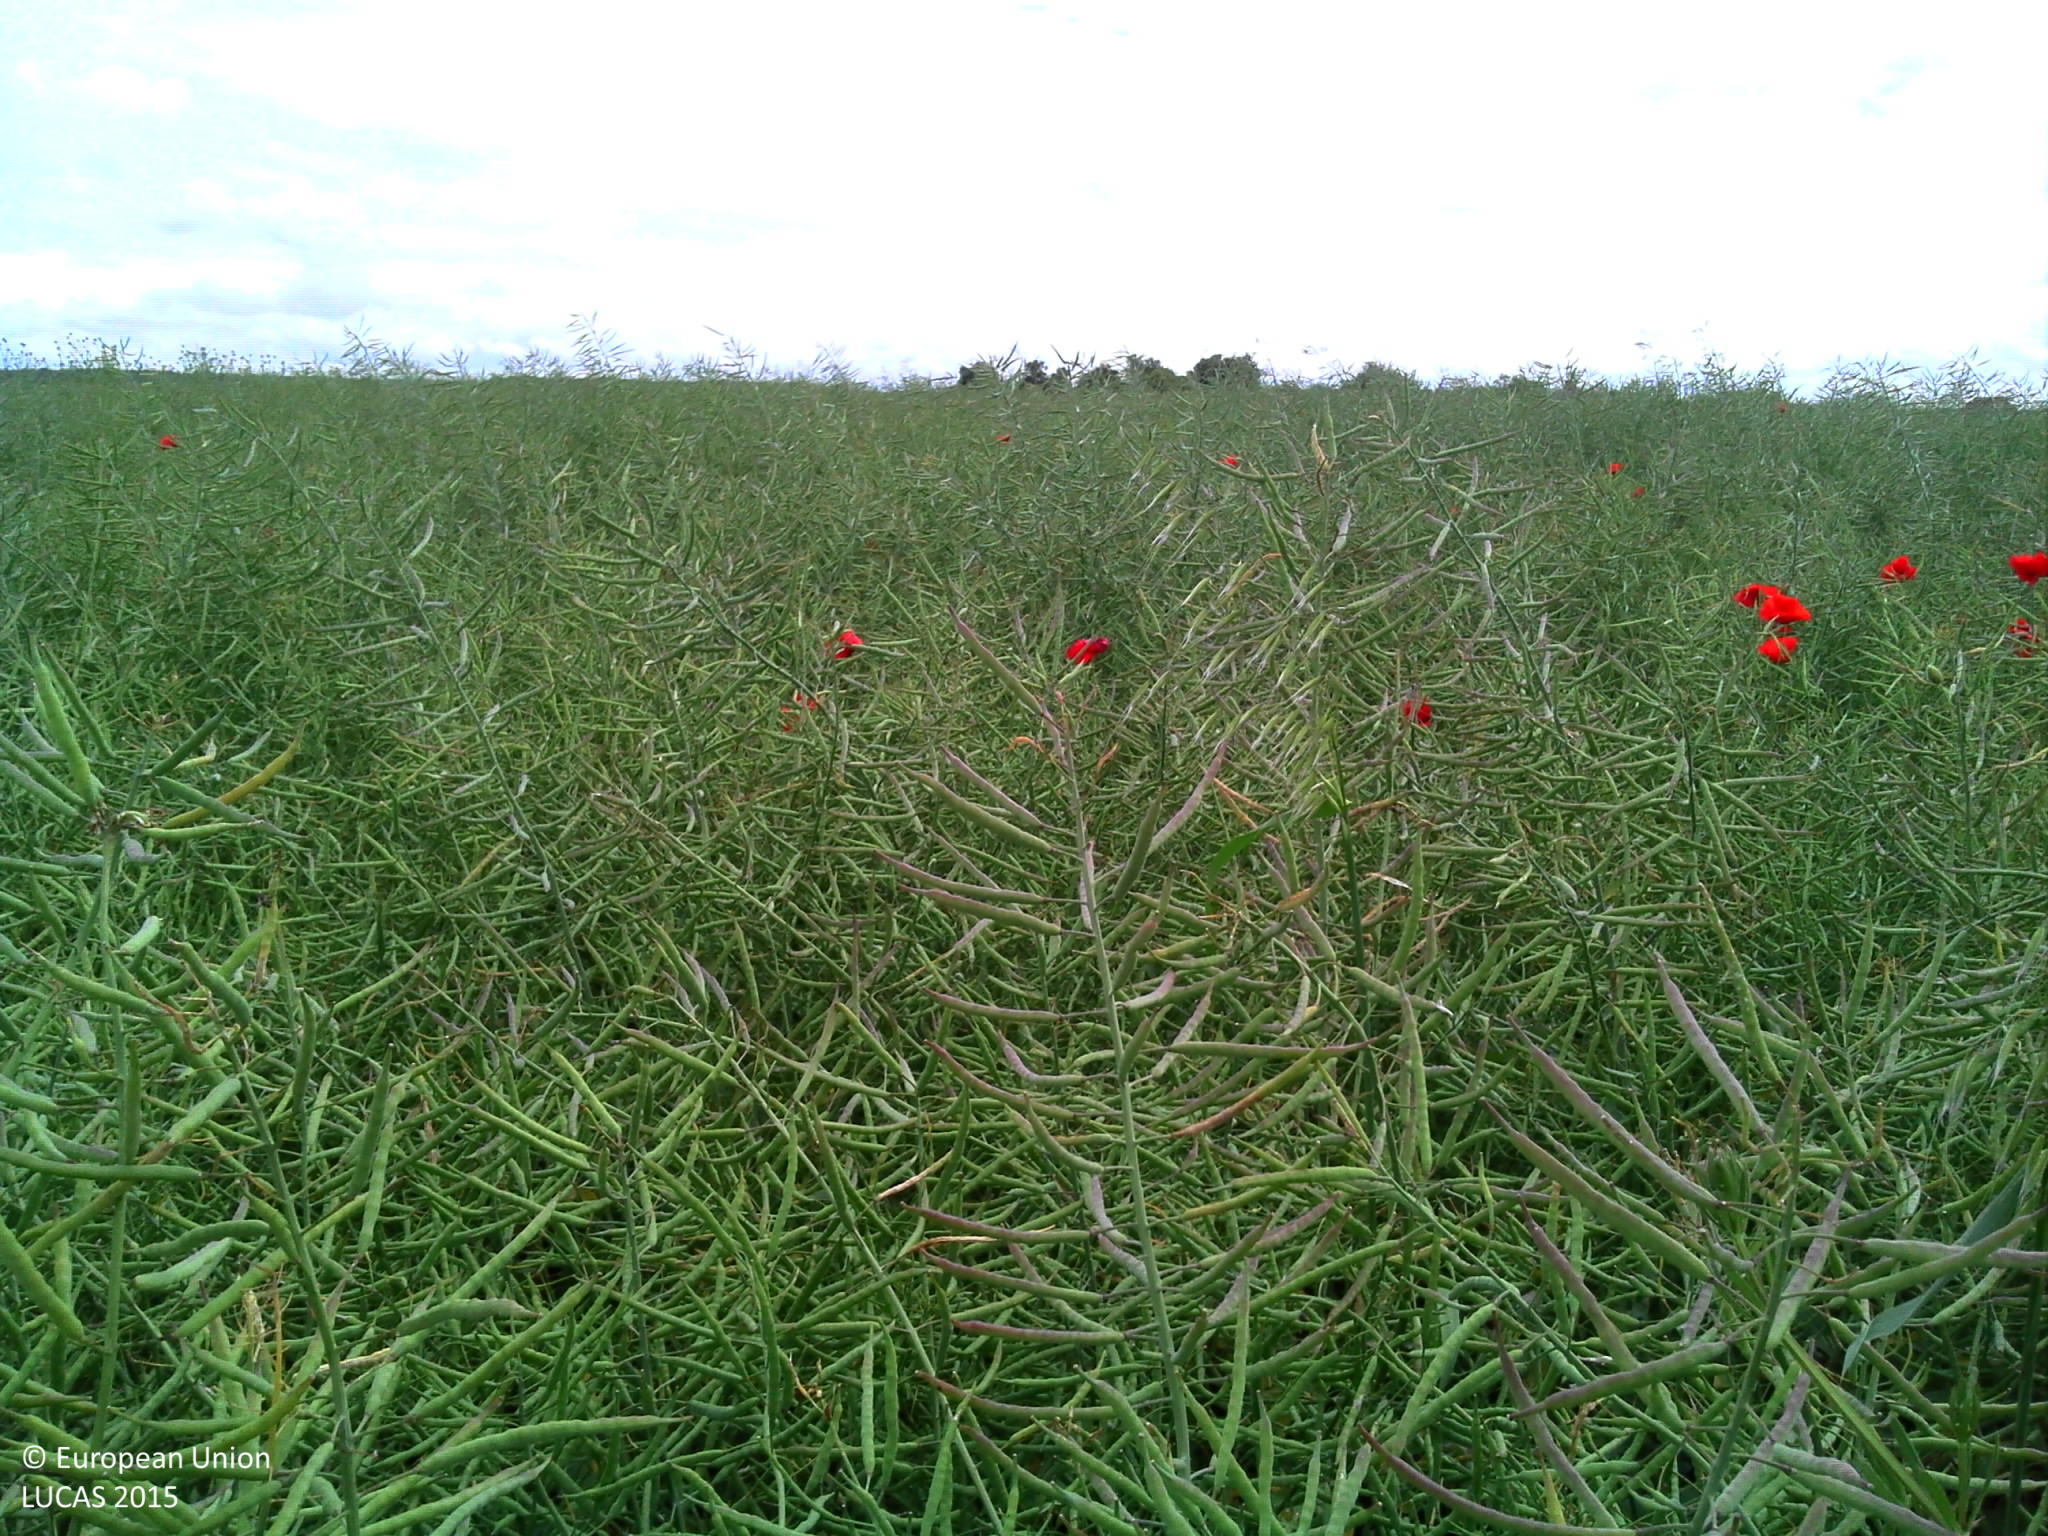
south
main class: Cropland
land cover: Rape and turnip rape
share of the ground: > 75 %
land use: Agriculture (excluding fallow land and kitchen gardens)
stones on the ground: < 10 %
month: May
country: FR
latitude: 47.0908
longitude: 2.8945
